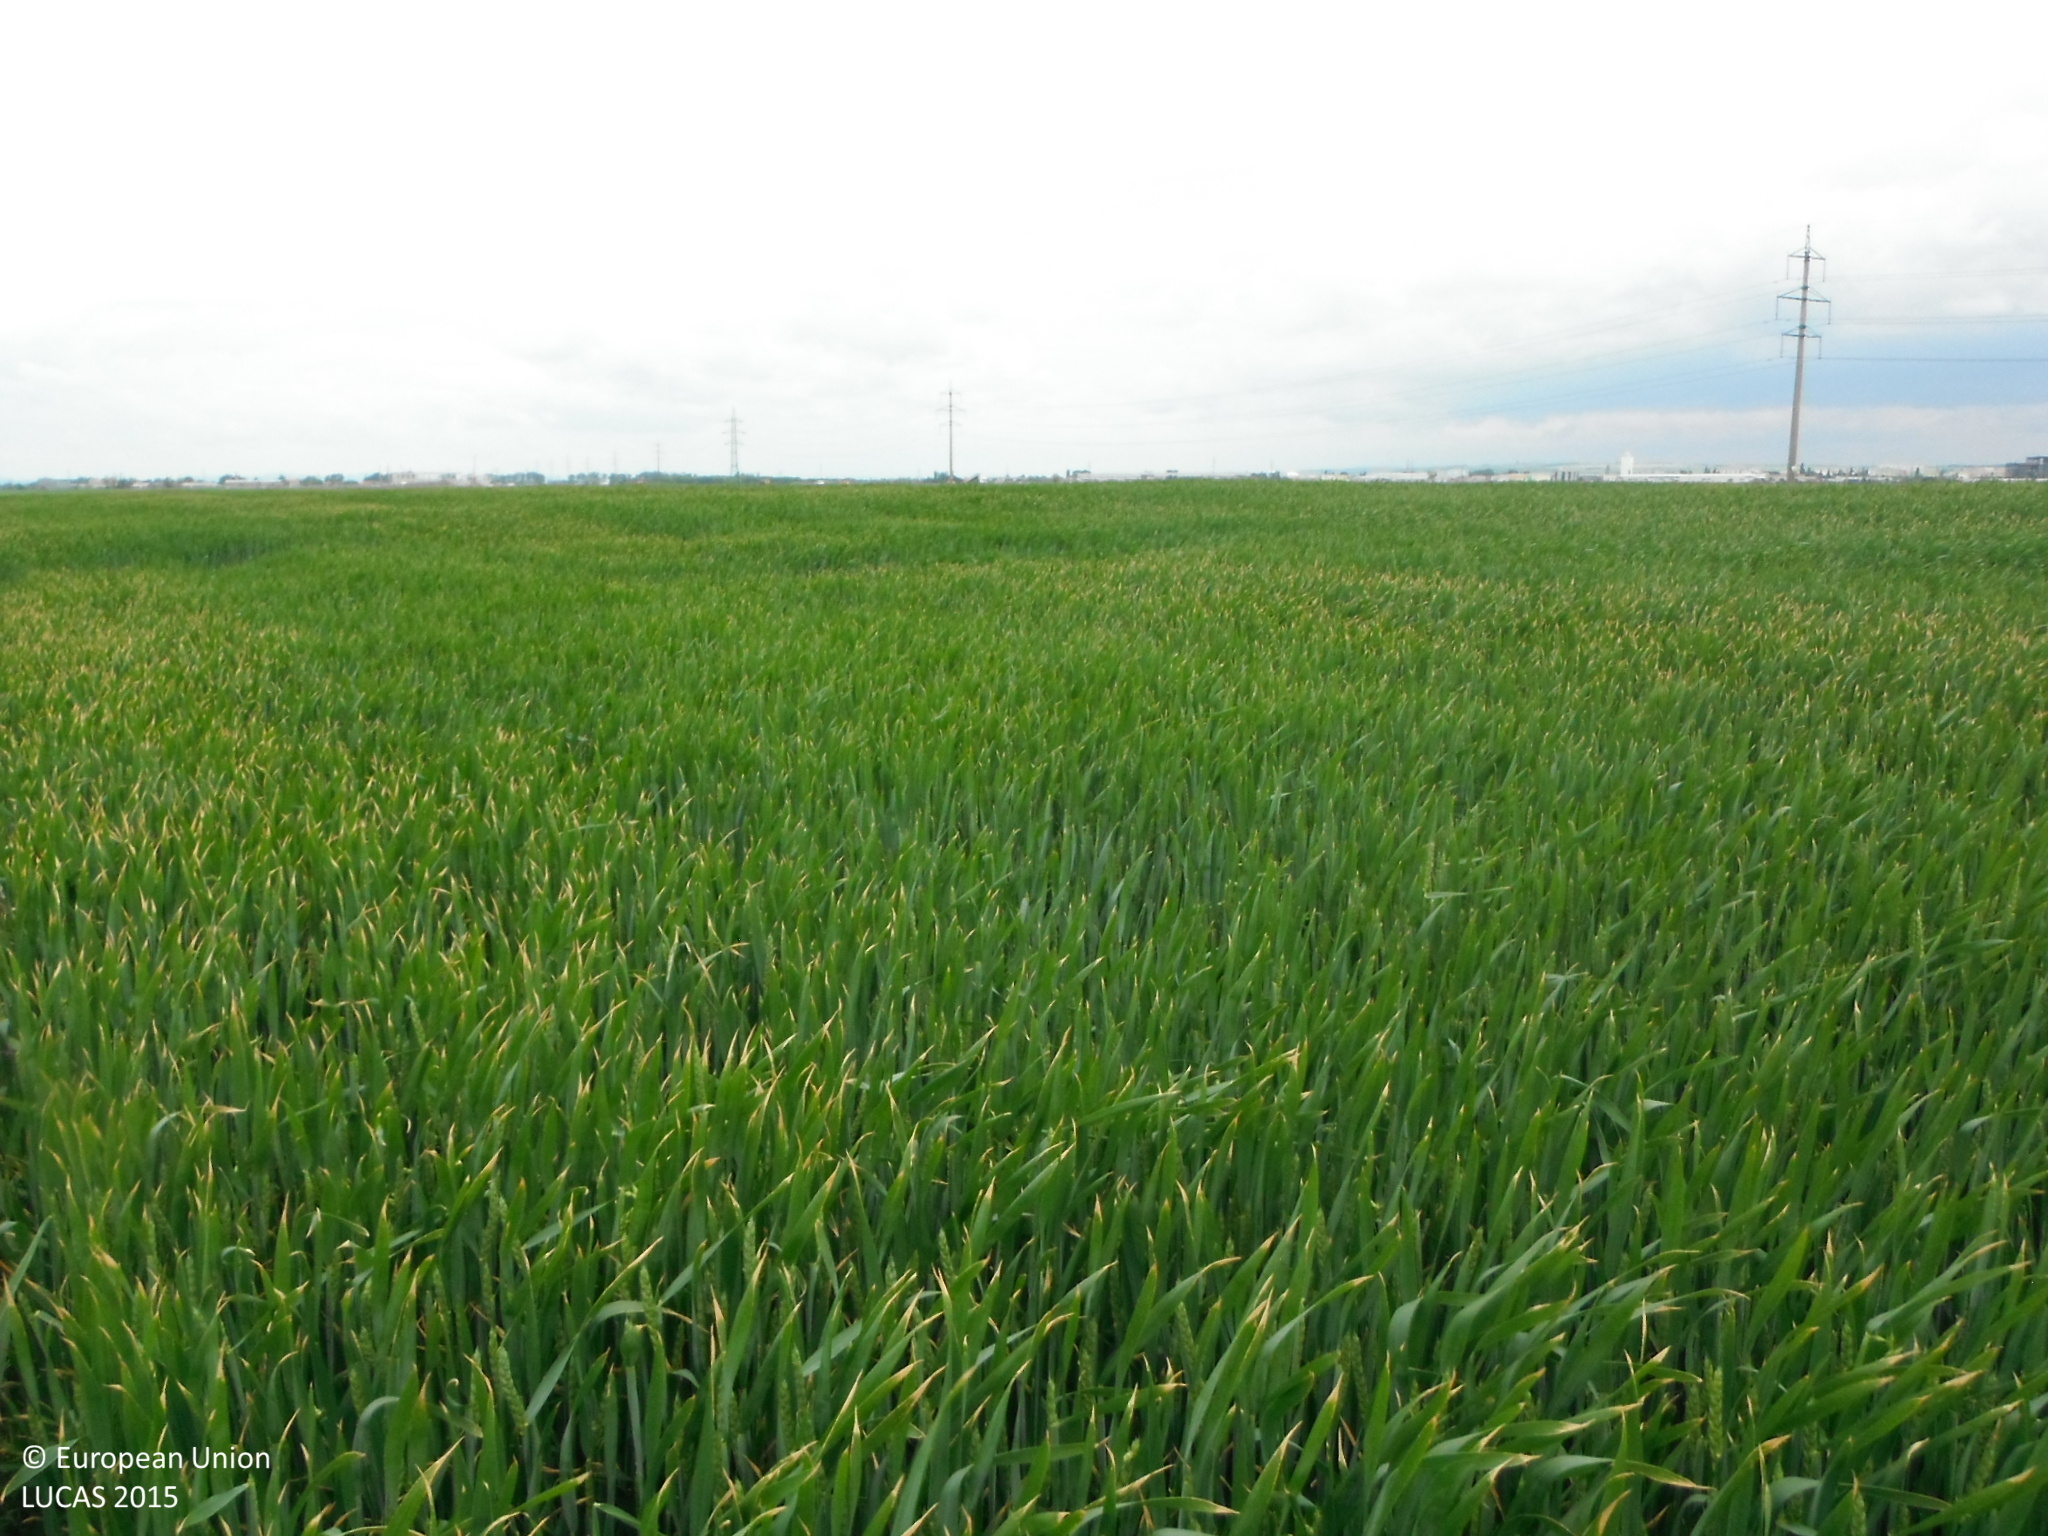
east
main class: Cropland
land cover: Common wheat
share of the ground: > 75 %
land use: Agriculture (excluding fallow land and kitchen gardens)
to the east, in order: Common wheat; Electric lines; Common wheat; Grass margins; Paved roads, cycling and walking lanes; Other bare soil
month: May
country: SK
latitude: 48.2611
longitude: 17.7029
